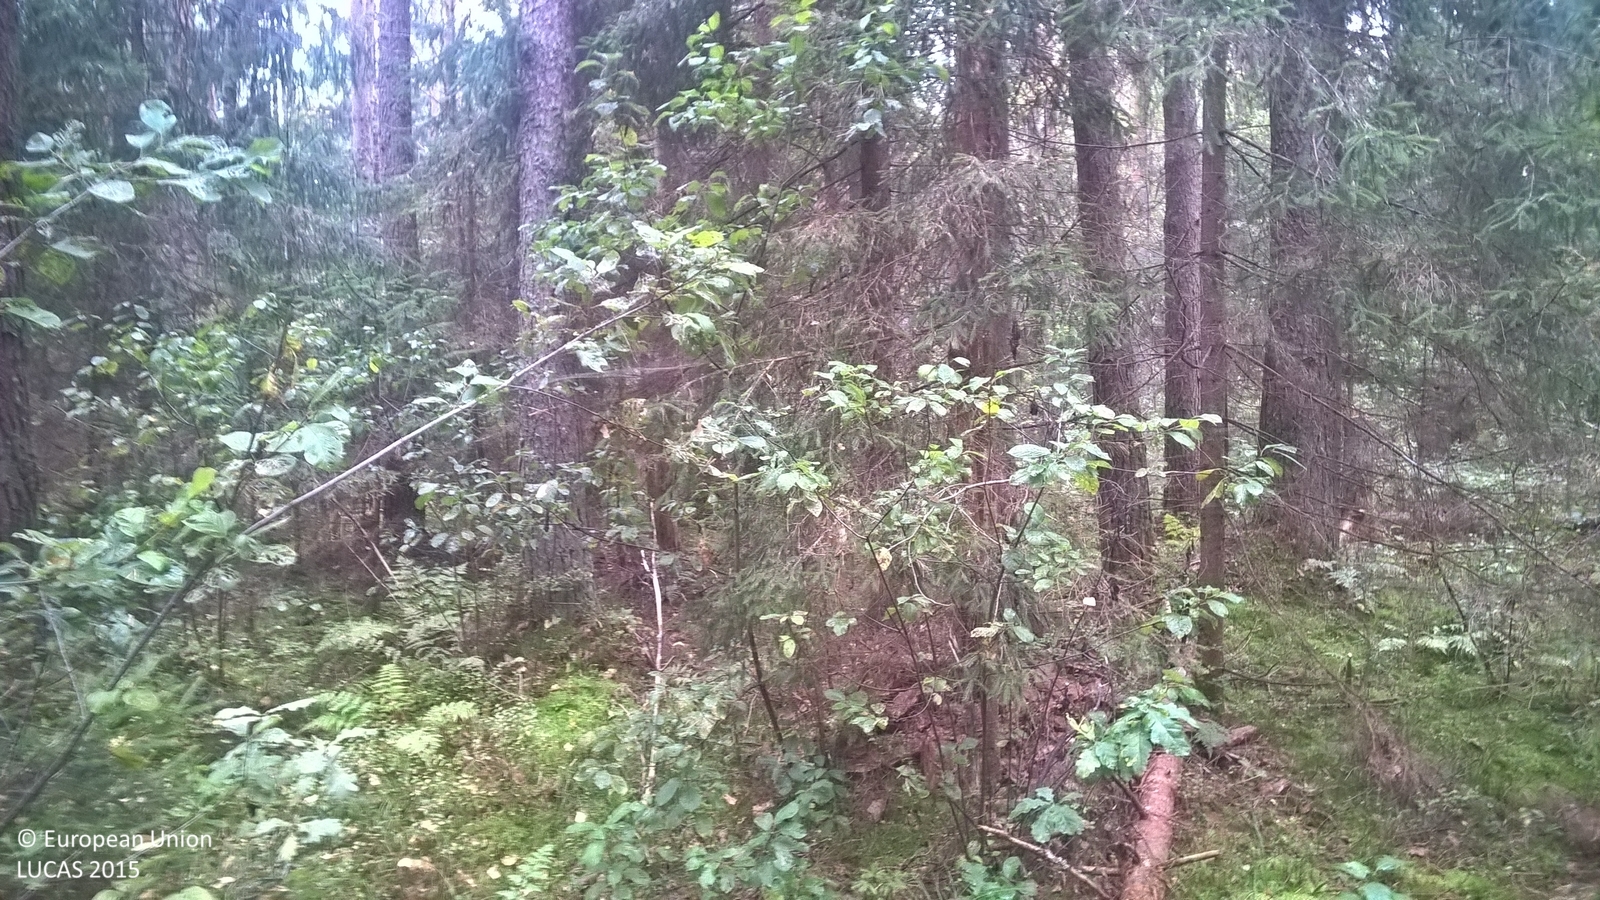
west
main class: Woodland
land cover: Other coniferous woodland
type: hemiboreal forest and nemoral coniferous forest and mixed broadleaved-coniferous forest
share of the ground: > 75 %
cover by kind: coniferous forest trees 75 %, broadleaved forest trees 10 %, herbaceous plants 10 %, shrubs 5 %
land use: Forestry
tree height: > 5 m
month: September
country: LV
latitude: 57.5172
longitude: 25.6280
